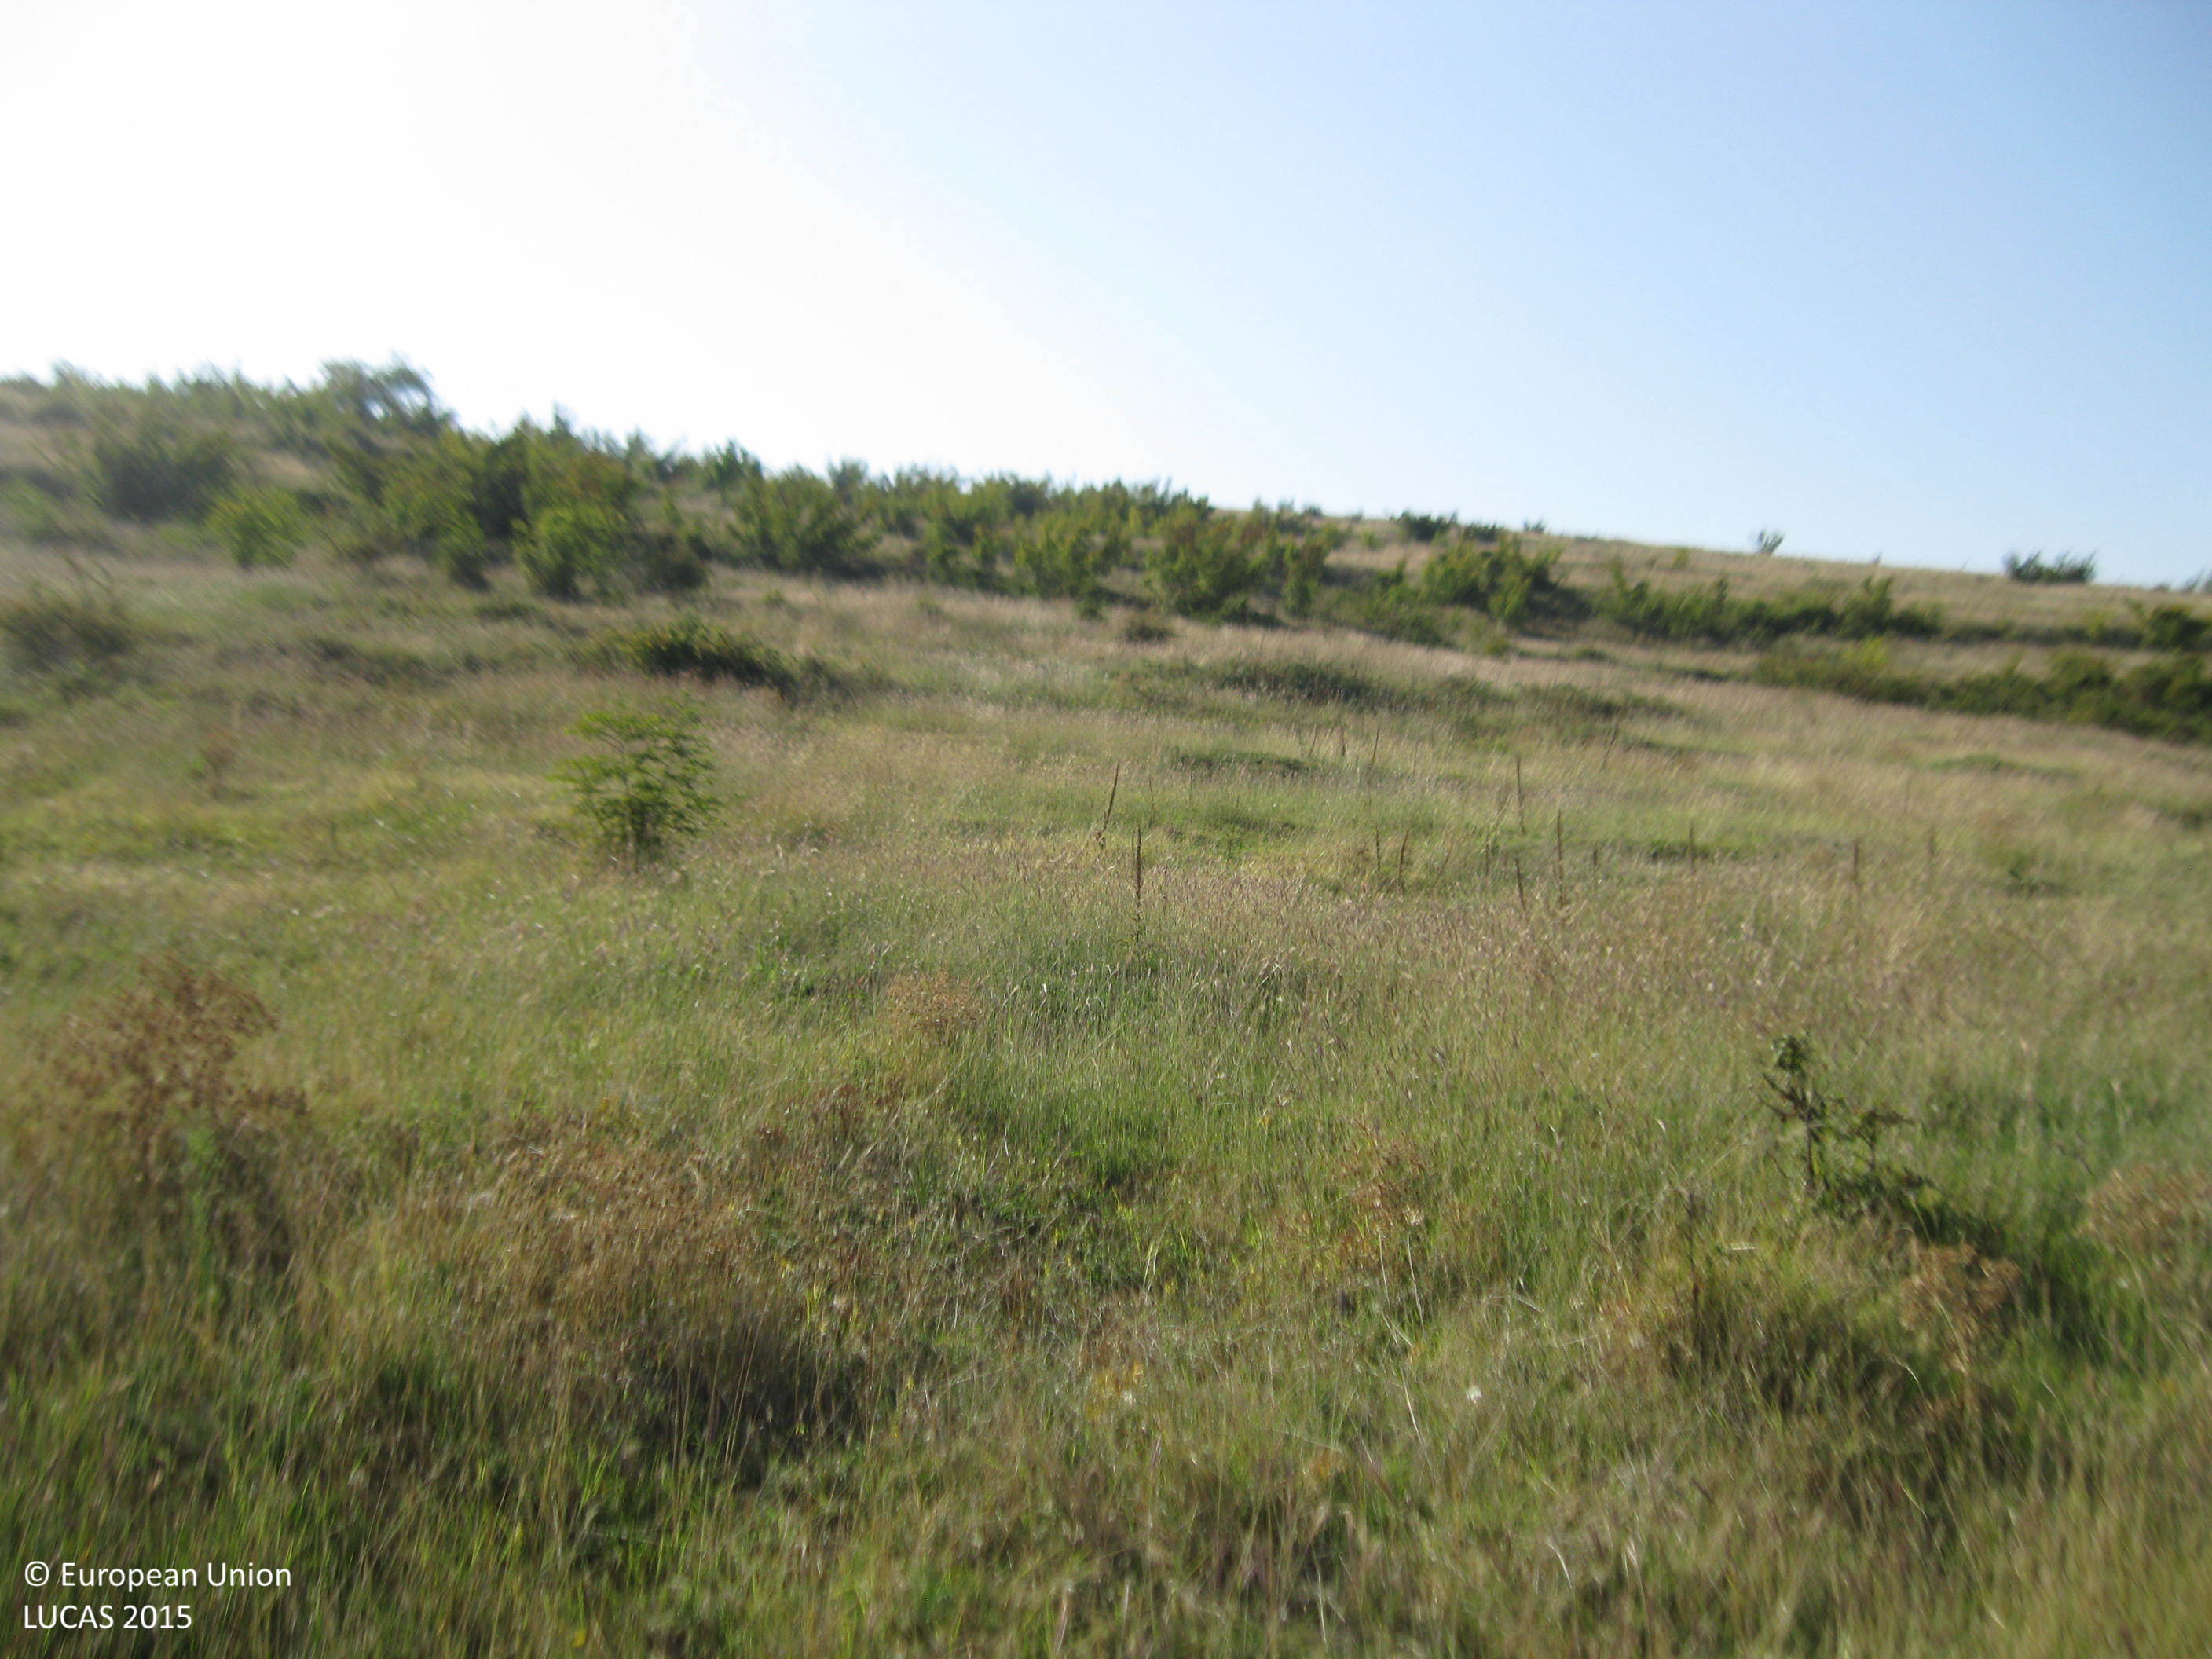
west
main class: Grassland
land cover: Grassland with sparse tree/shrub cover
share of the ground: > 75 %
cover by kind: herbaceous plants 90 %, broadleaved forest trees 5 %, shrubs 5 %
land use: Agriculture (excluding fallow land and kitchen gardens)
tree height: < 5 m
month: September
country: BG
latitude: 42.0787
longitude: 24.6385
